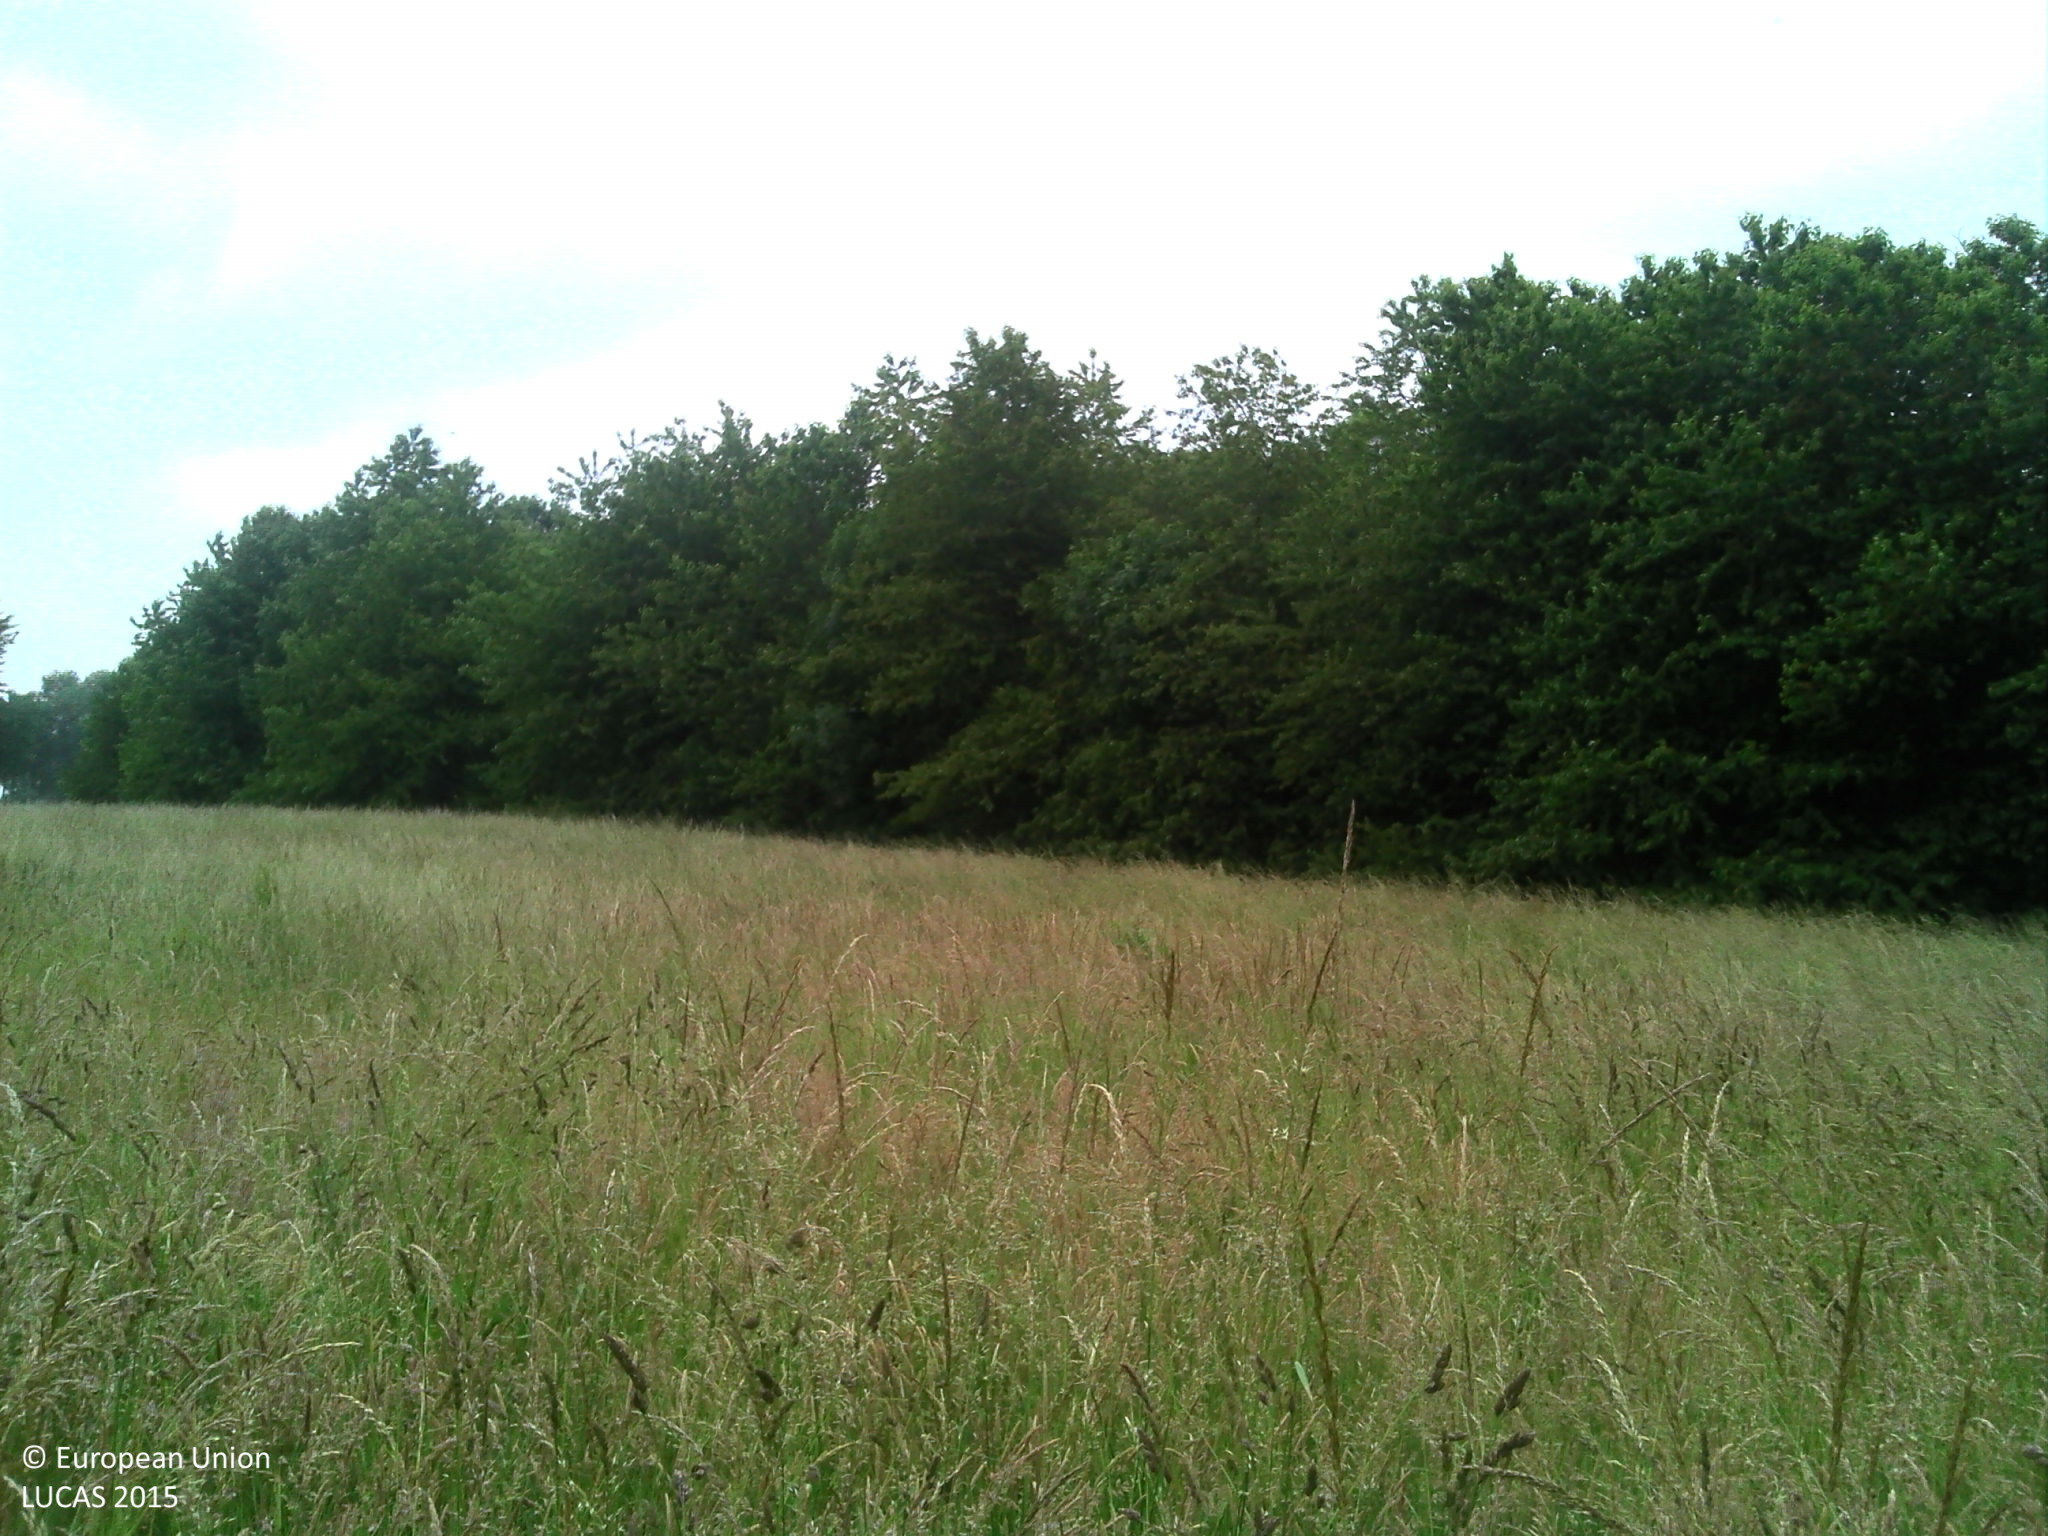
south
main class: Grassland
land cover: Grassland without tree/shrub cover
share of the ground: > 75 %
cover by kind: herbaceous plants 100 %
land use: Agriculture (excluding fallow land and kitchen gardens)
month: June
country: FR
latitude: 49.5620
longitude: 2.5640
